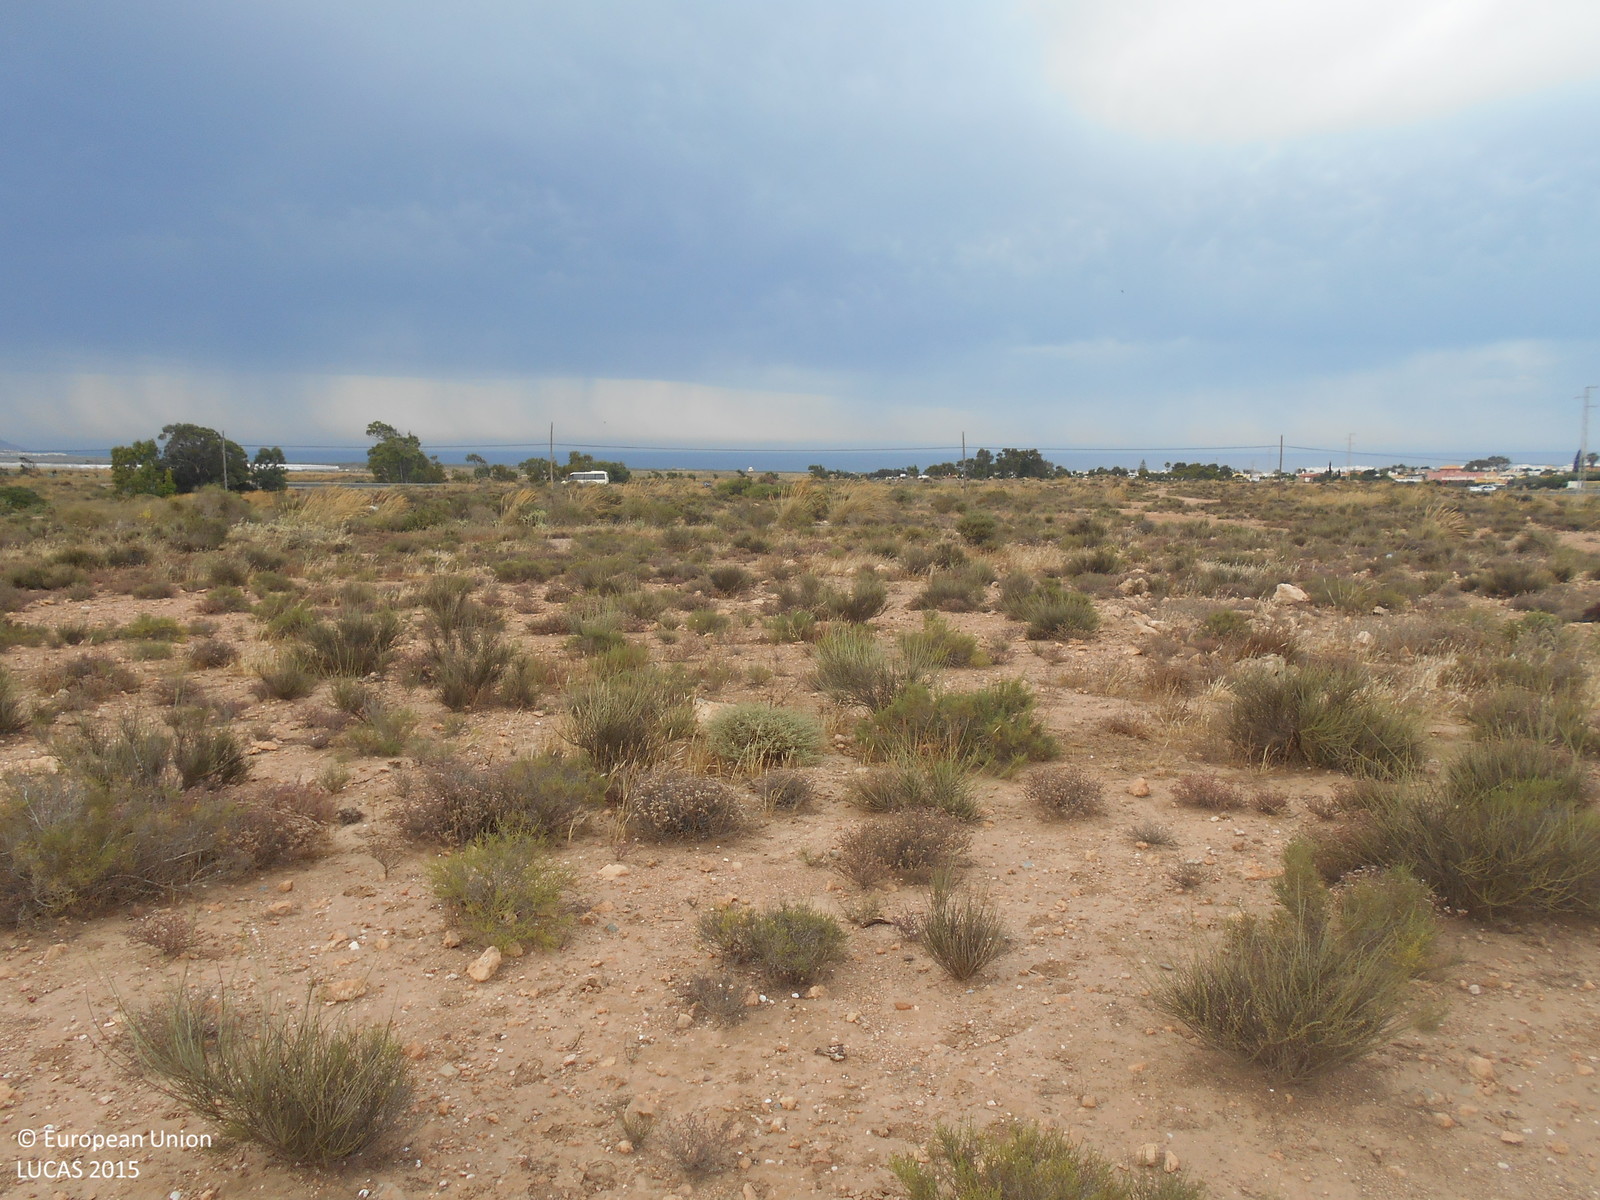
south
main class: Shrubland
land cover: Shrubland without tree cover
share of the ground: 10 - 25 %
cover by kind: unconsolidated bare surface 70 %, shrubs 20 %, herbaceous plants 10 %
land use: Semi-natural and natural areas not in use
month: May
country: ES
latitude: 36.8541
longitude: -2.3004
